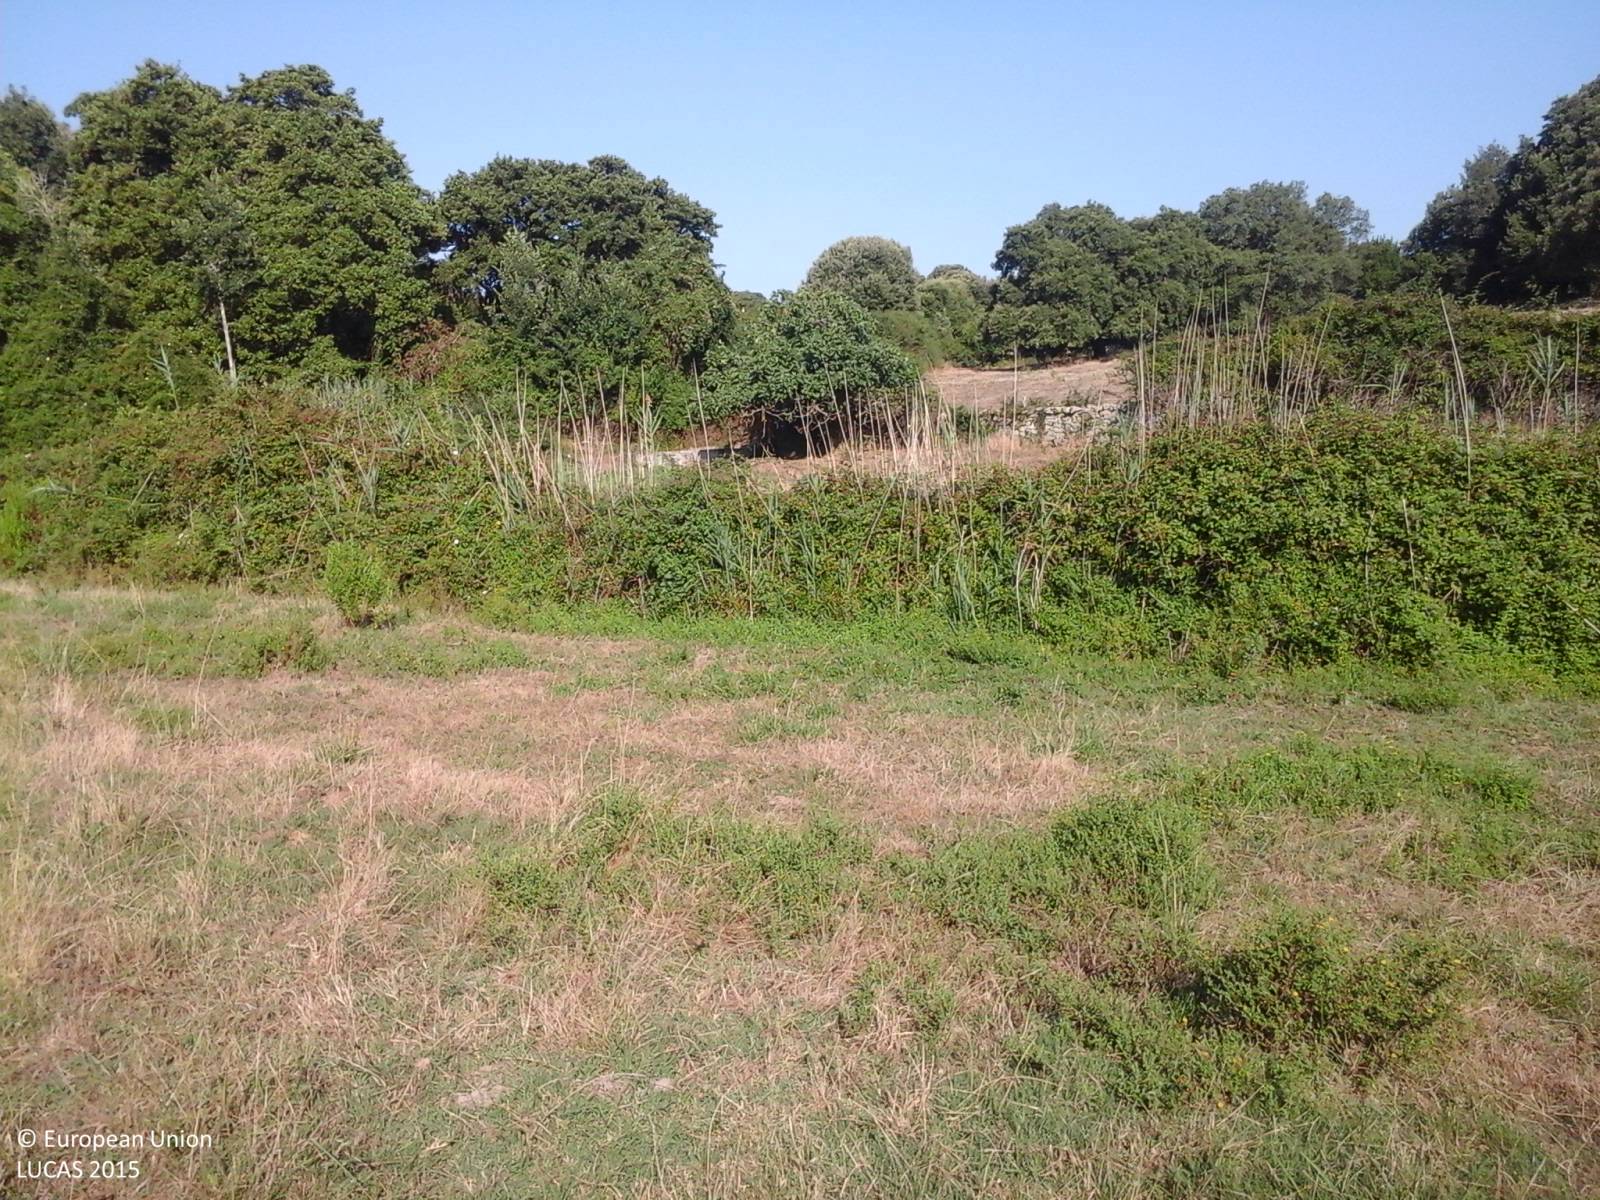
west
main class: Grassland
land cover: Grassland without tree/shrub cover
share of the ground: > 75 %
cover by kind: herbaceous plants 100 %
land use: Agriculture (excluding fallow land and kitchen gardens)
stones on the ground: < 10 %
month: August
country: IT
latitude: 40.9152
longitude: 9.1609
